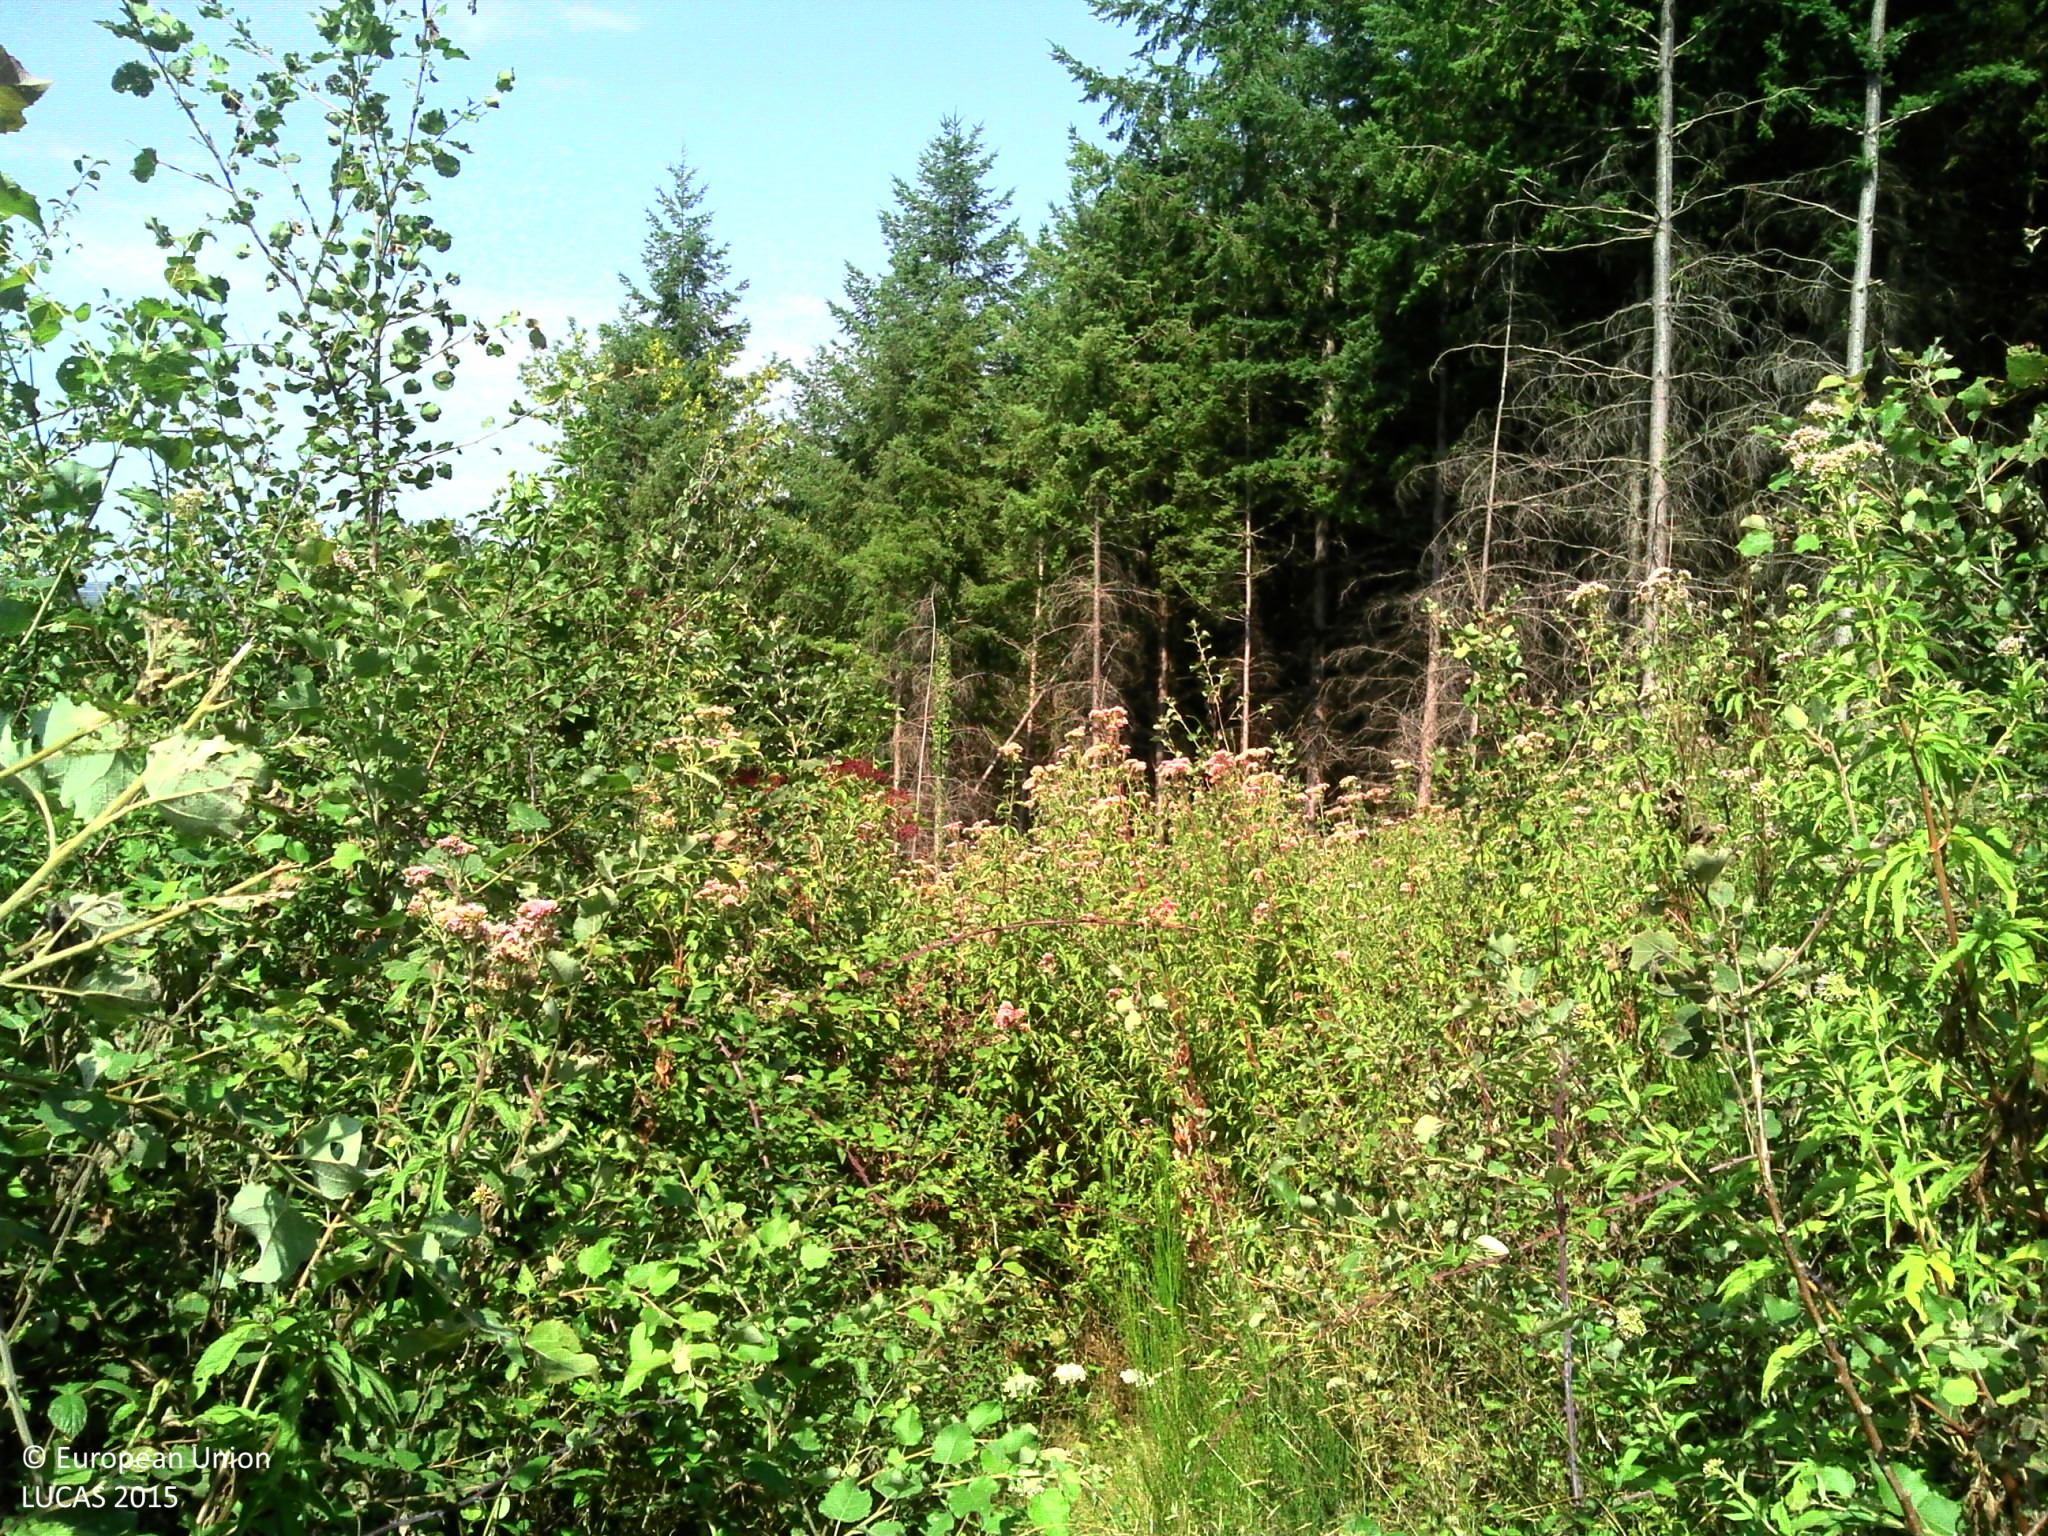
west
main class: Woodland
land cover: Broadleaved woodland
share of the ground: 50 - 75 %
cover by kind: broadleaved forest trees 60 %, shrubs 20 %, herbaceous plants 20 %
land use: Semi-natural and natural areas not in use
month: August
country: FR
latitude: 45.2418
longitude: 1.8304
